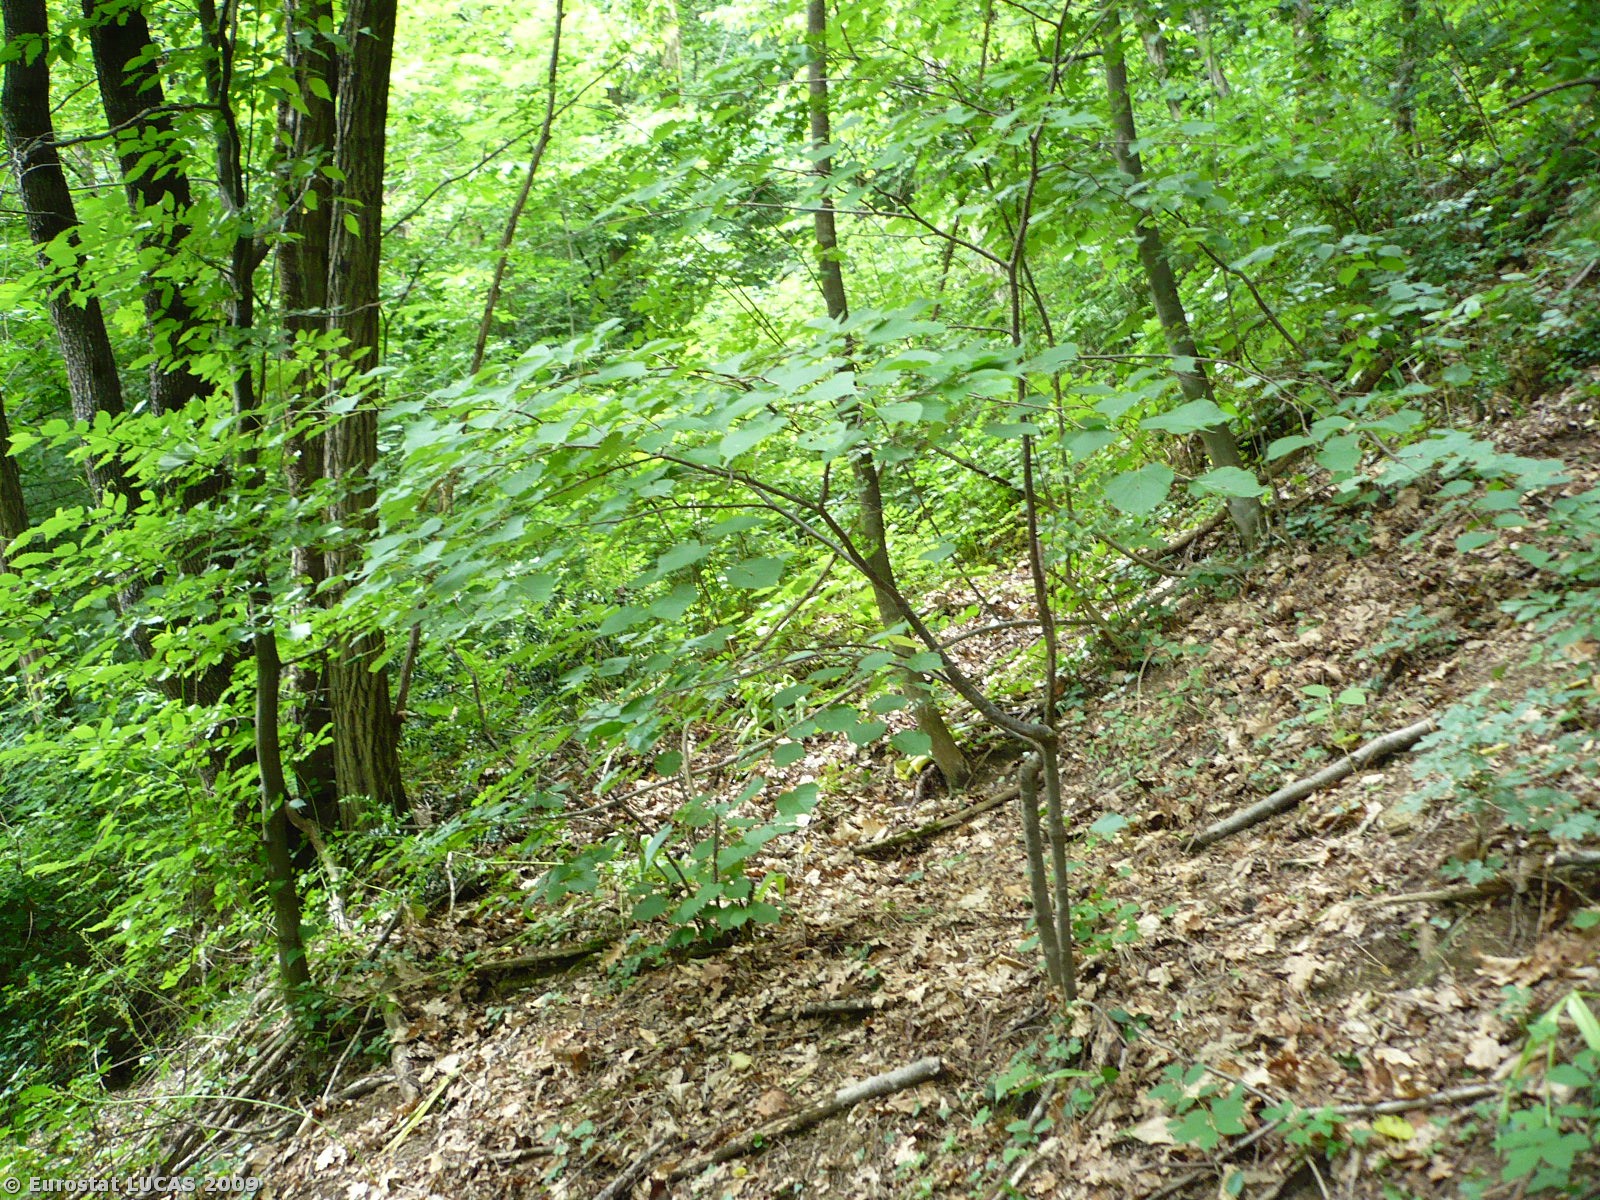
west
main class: Woodland
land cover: Broadleaved woodland
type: beech forest
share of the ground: > 75 %
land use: Unused
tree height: > 5 m
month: June
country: SI
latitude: 46.1084
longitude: 13.6578
